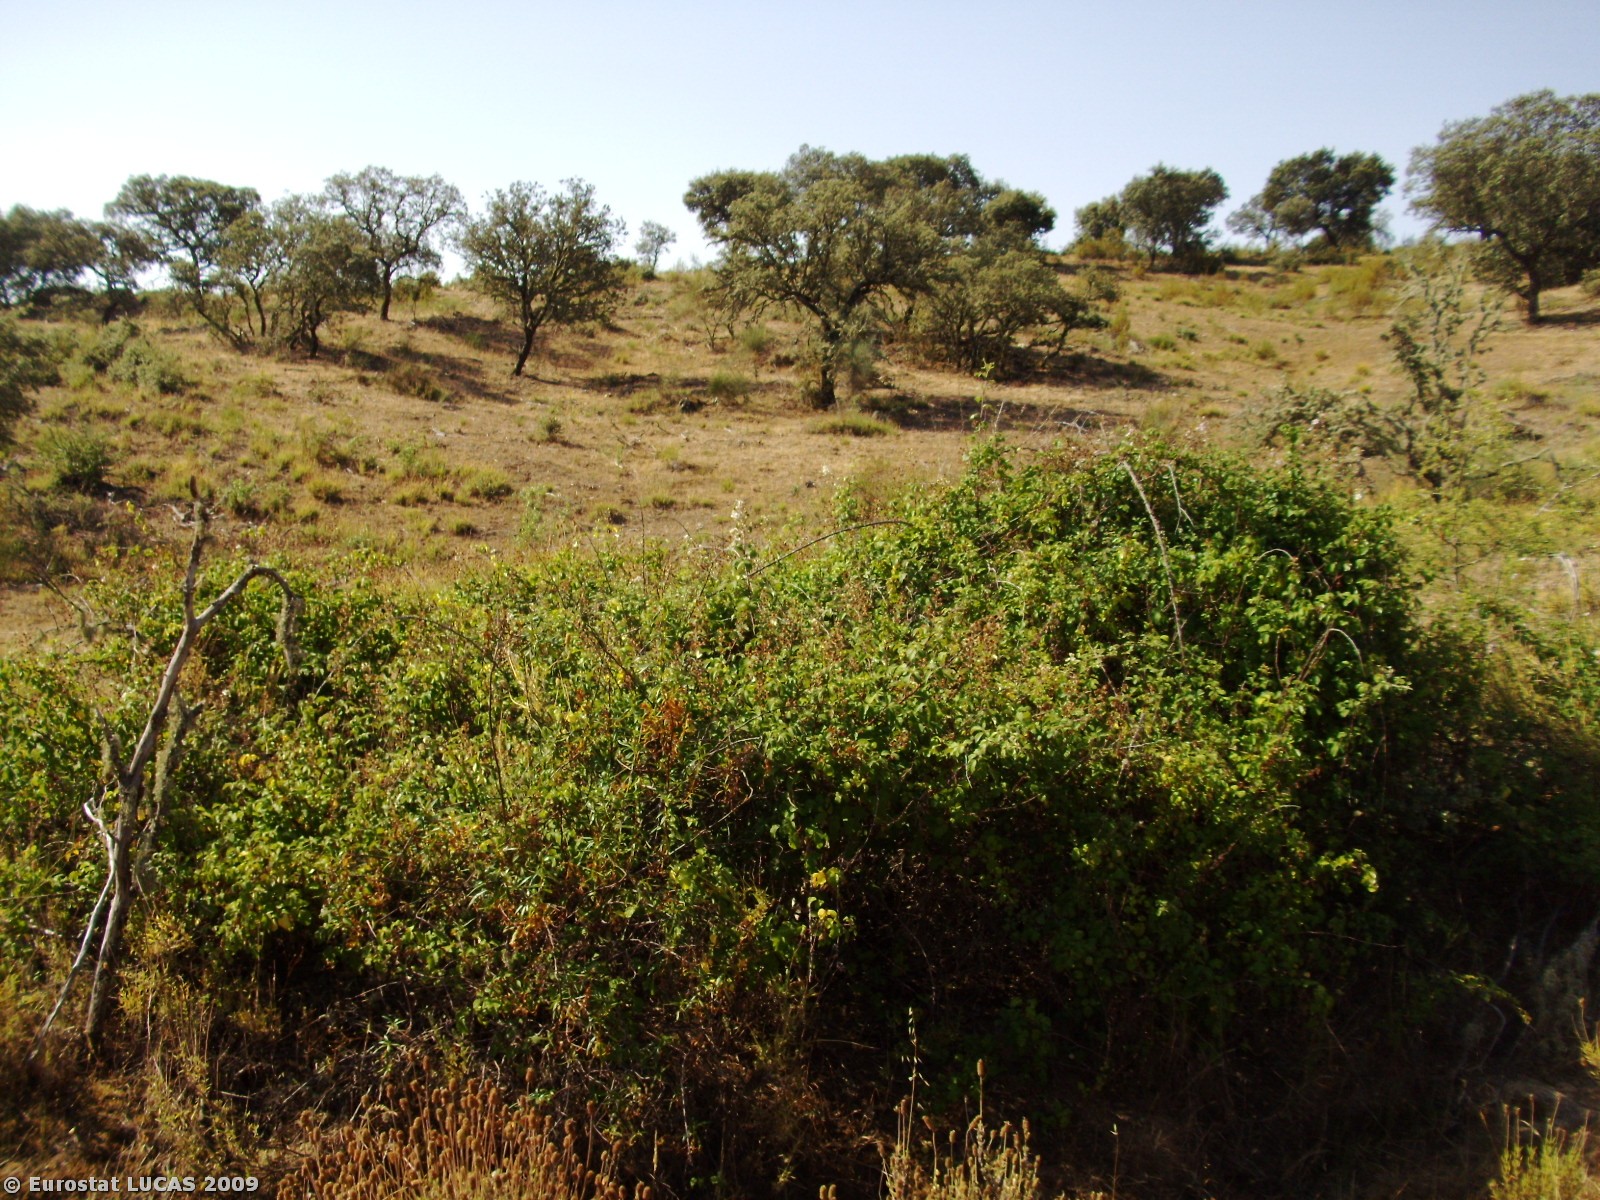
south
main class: Woodland
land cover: Broadleaved woodland
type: broadleaved evergreen forest
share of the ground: 50 - 75 %
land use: Forestry
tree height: > 5 m
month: June
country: PT
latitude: 39.9835
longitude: -7.1319
